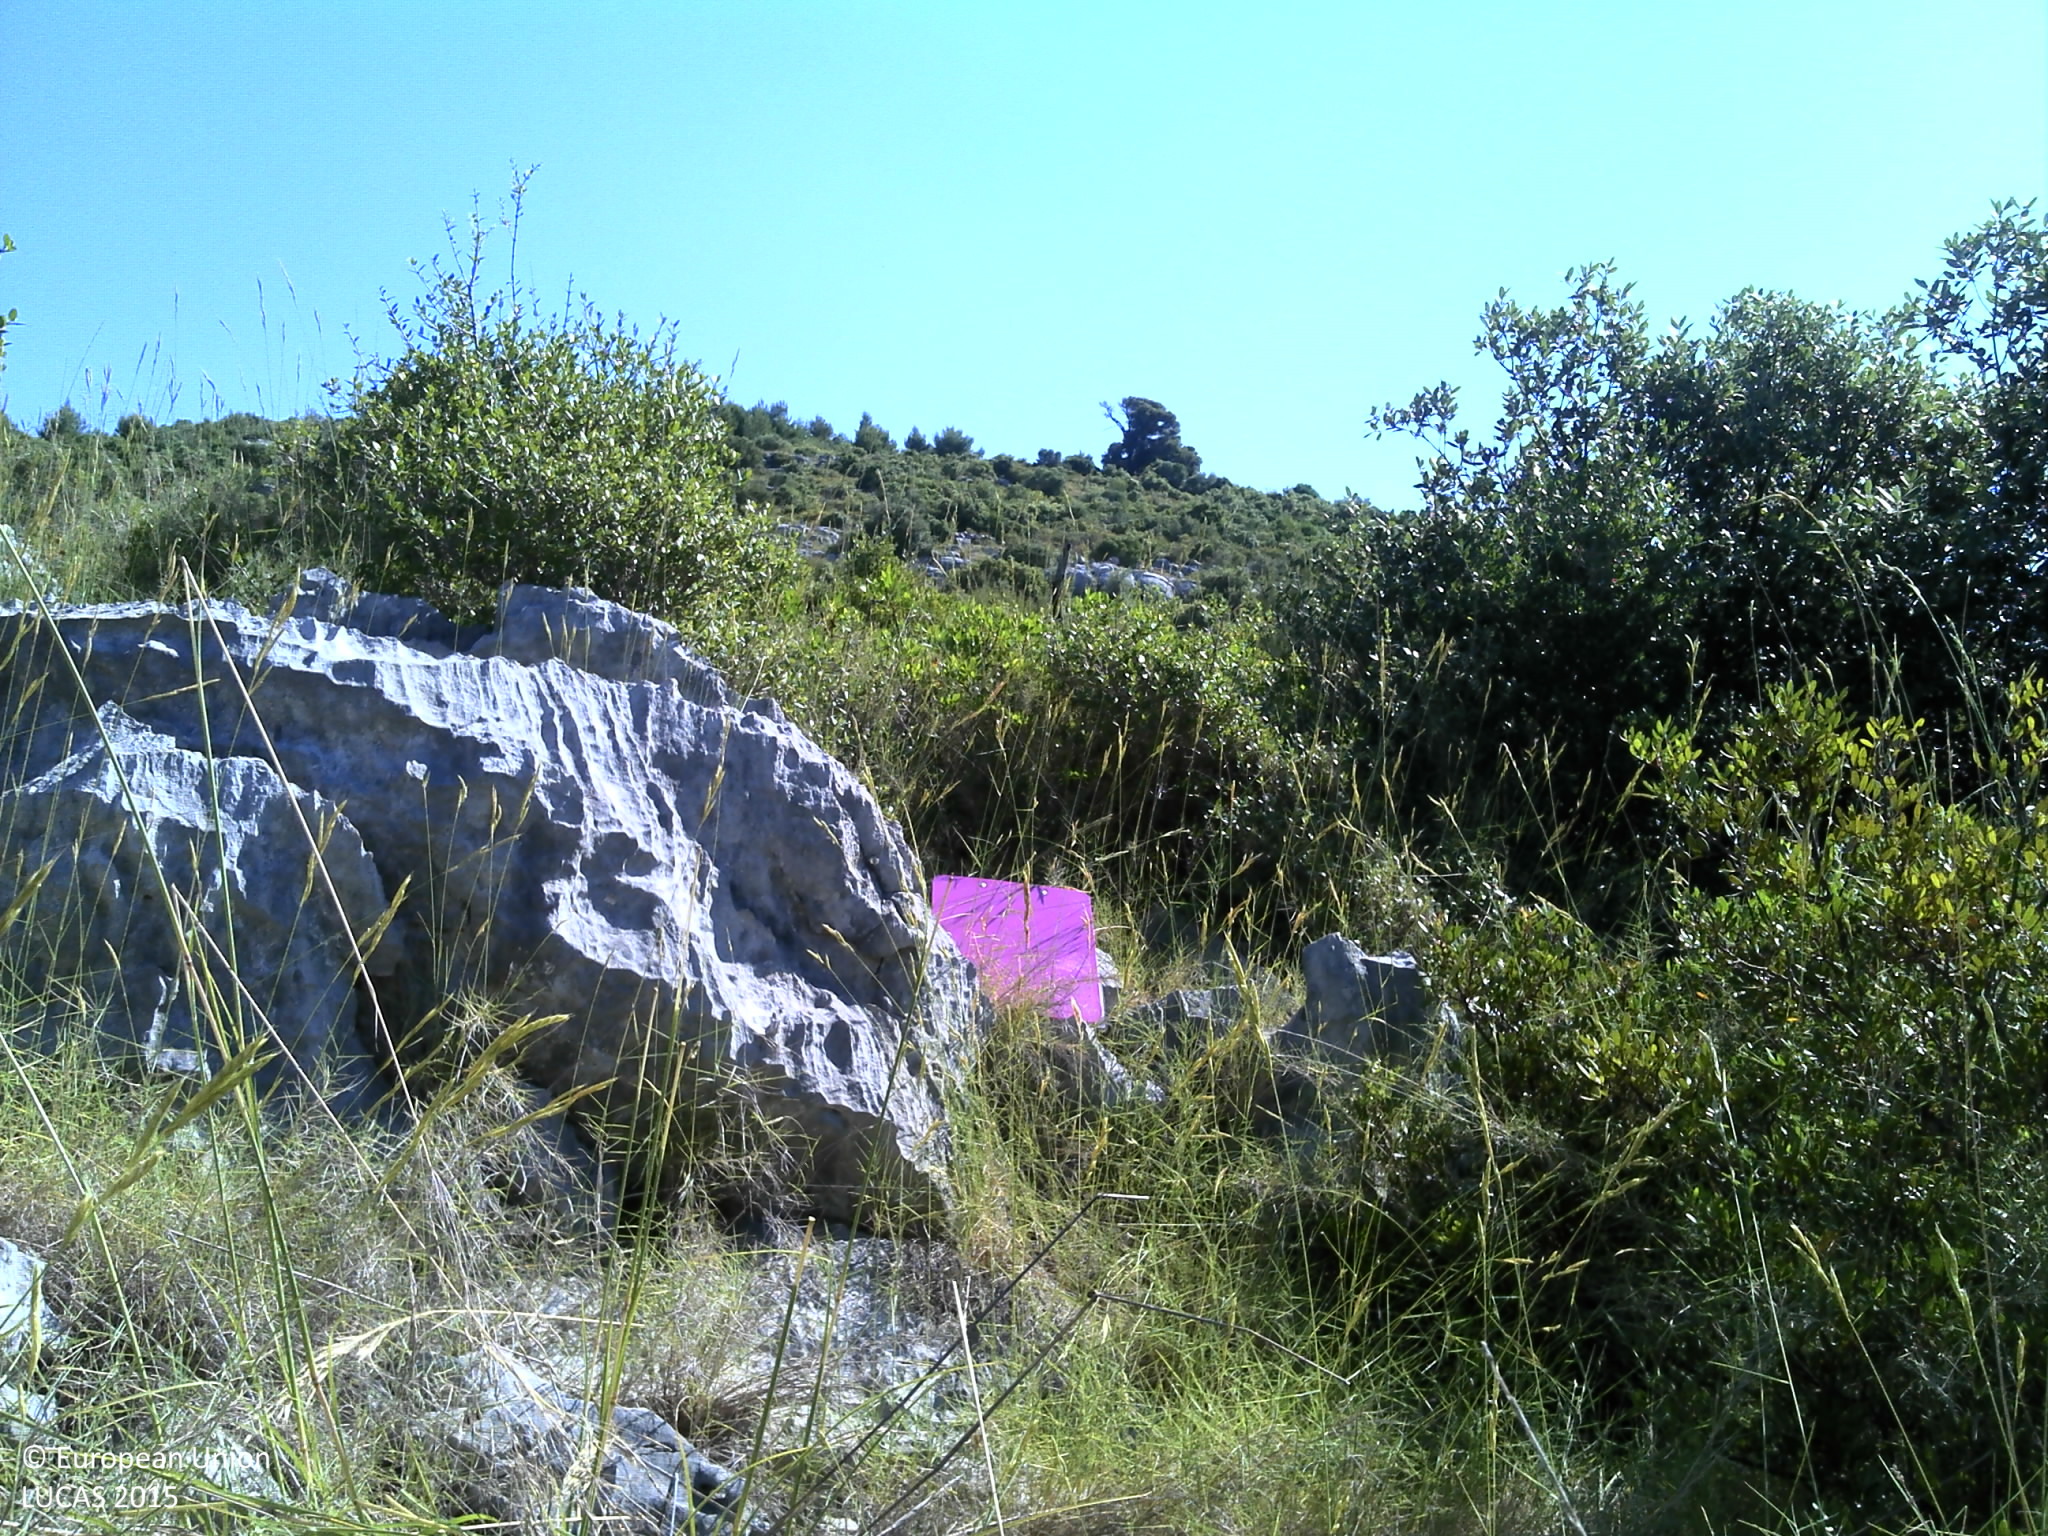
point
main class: Shrubland
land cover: Shrubland without tree cover
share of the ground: 25 - 50 %
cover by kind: shrubs 50 %, consolidated bare surface 20 %, unconsolidated bare surface 20 %, herbaceous plants 10 %
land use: Semi-natural and natural areas not in use
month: June
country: HR
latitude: 43.5205
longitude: 16.0896
